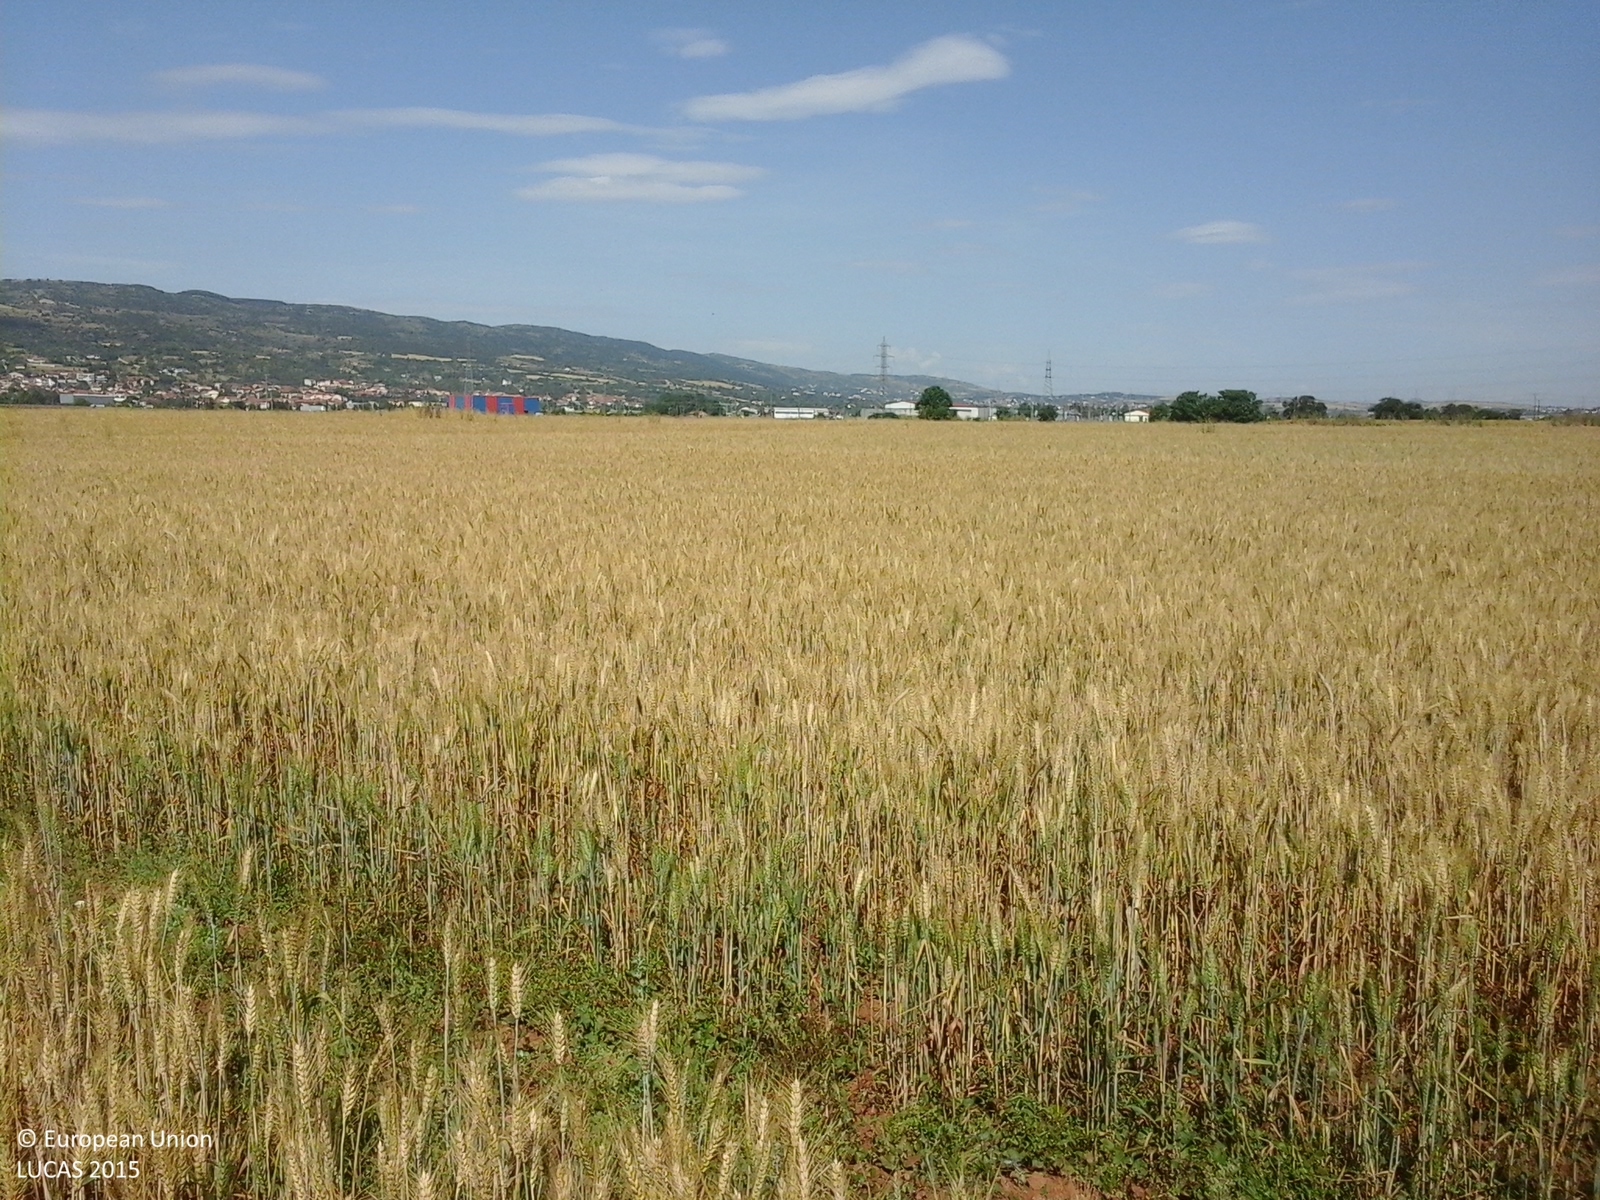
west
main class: Cropland
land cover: Common wheat
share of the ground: > 75 %
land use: Agriculture (excluding fallow land and kitchen gardens)
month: June
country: GR
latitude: 40.7519
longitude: 23.0023
